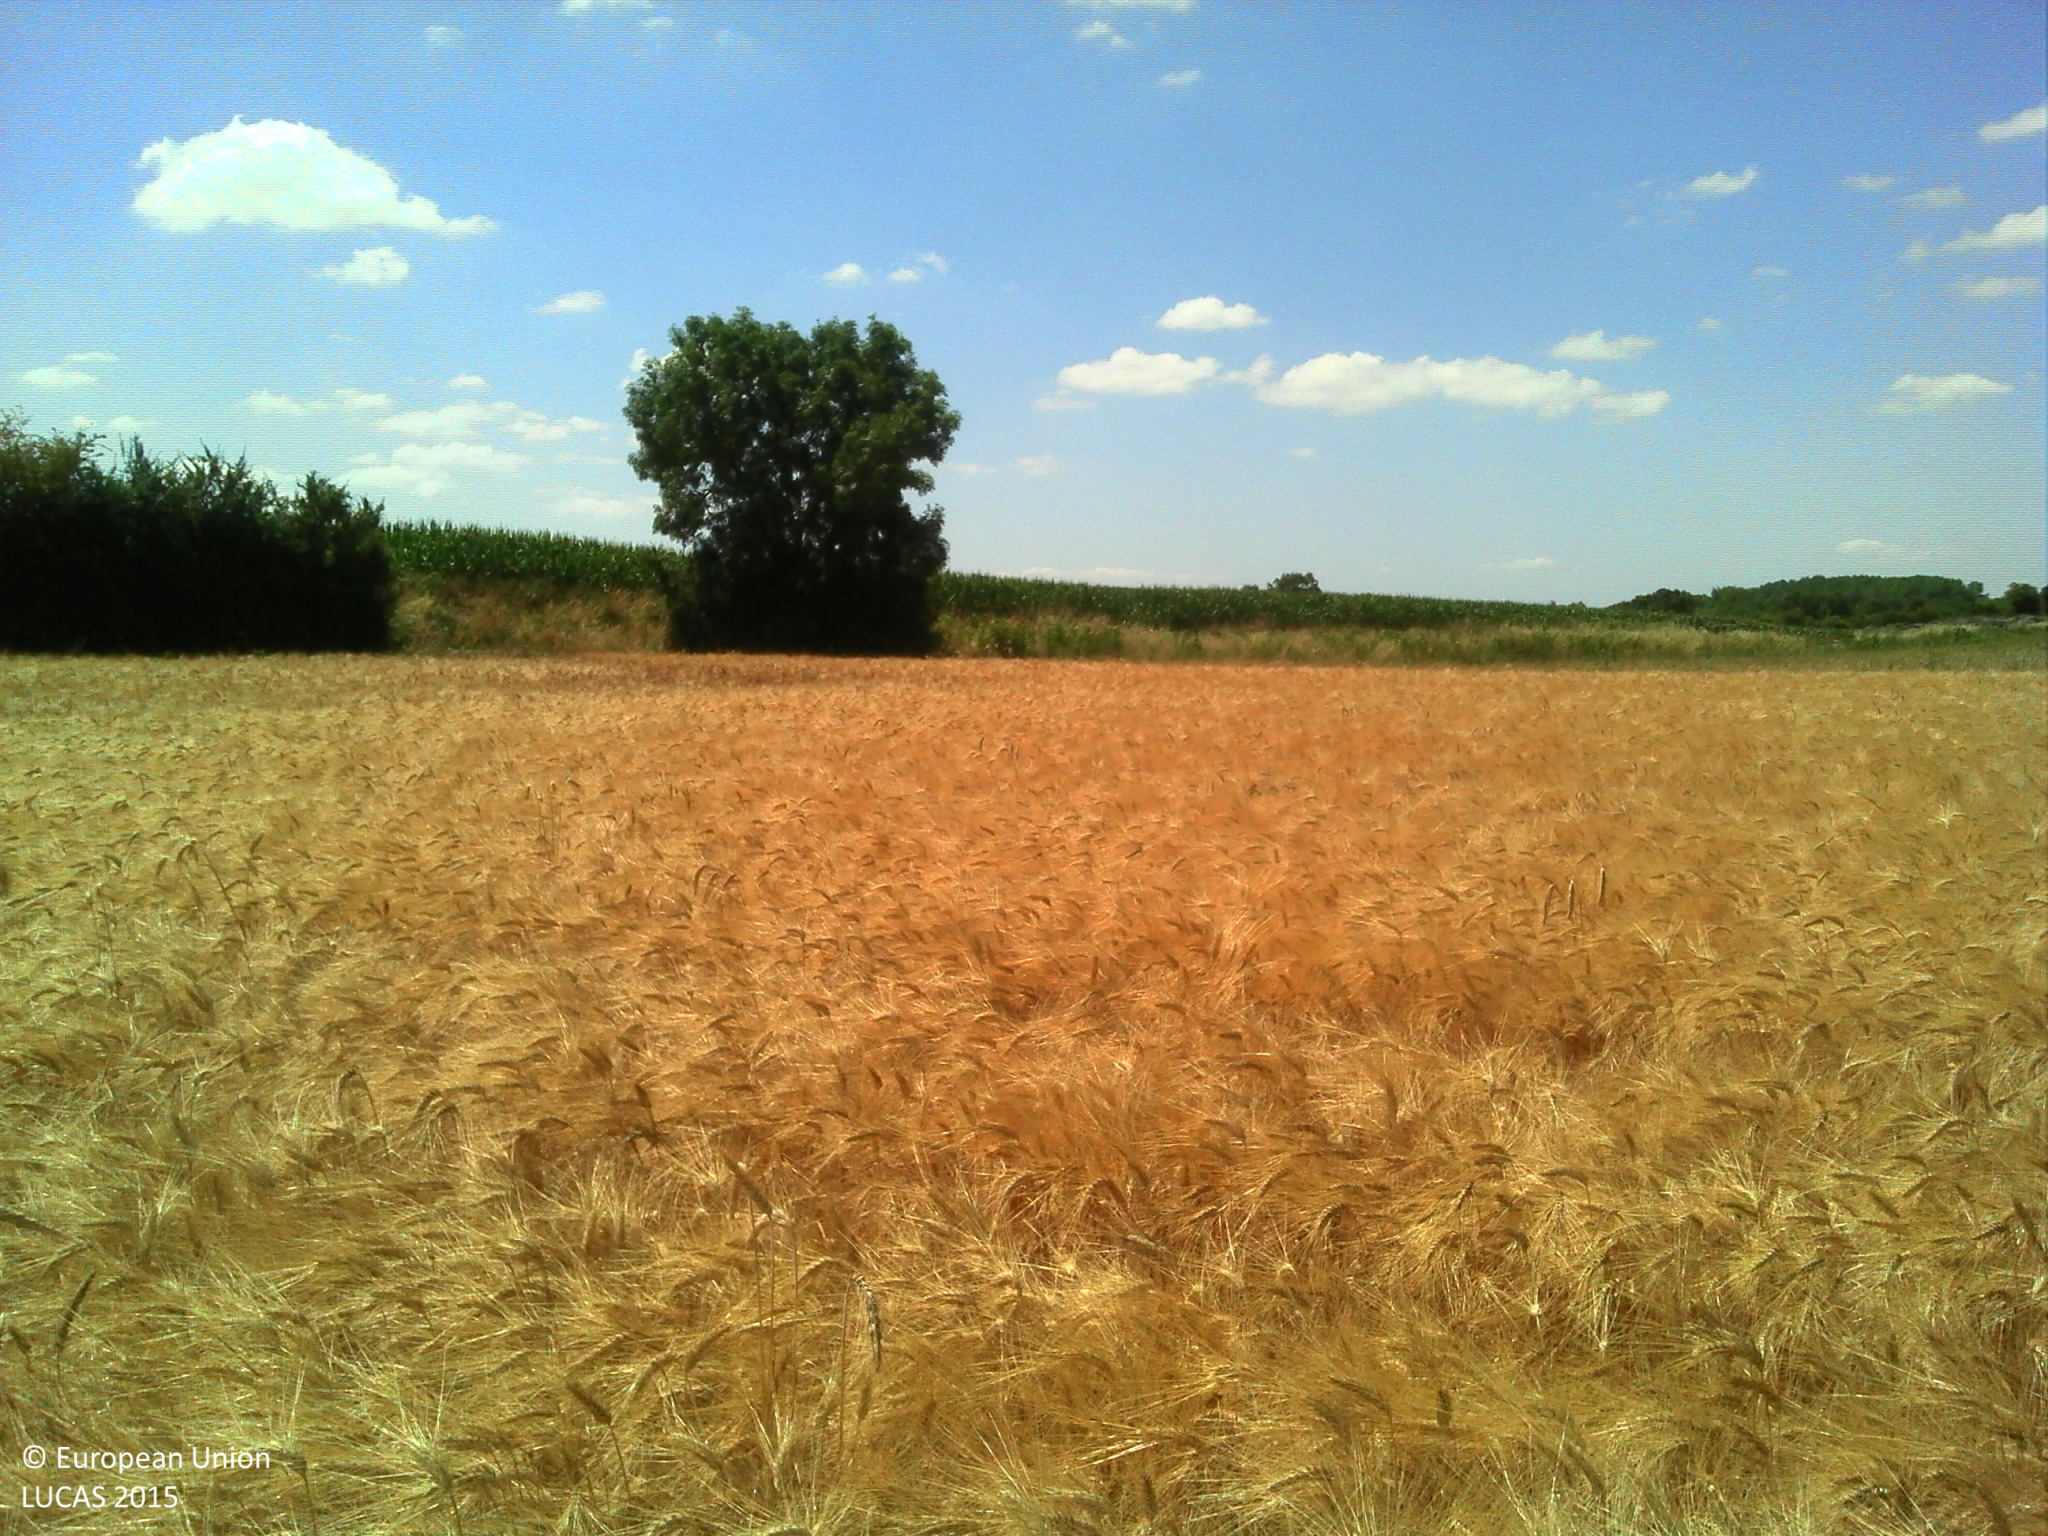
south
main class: Cropland
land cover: Common wheat
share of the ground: > 75 %
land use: Agriculture (excluding fallow land and kitchen gardens)
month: July
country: FR
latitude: 46.4390
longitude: -1.3199
